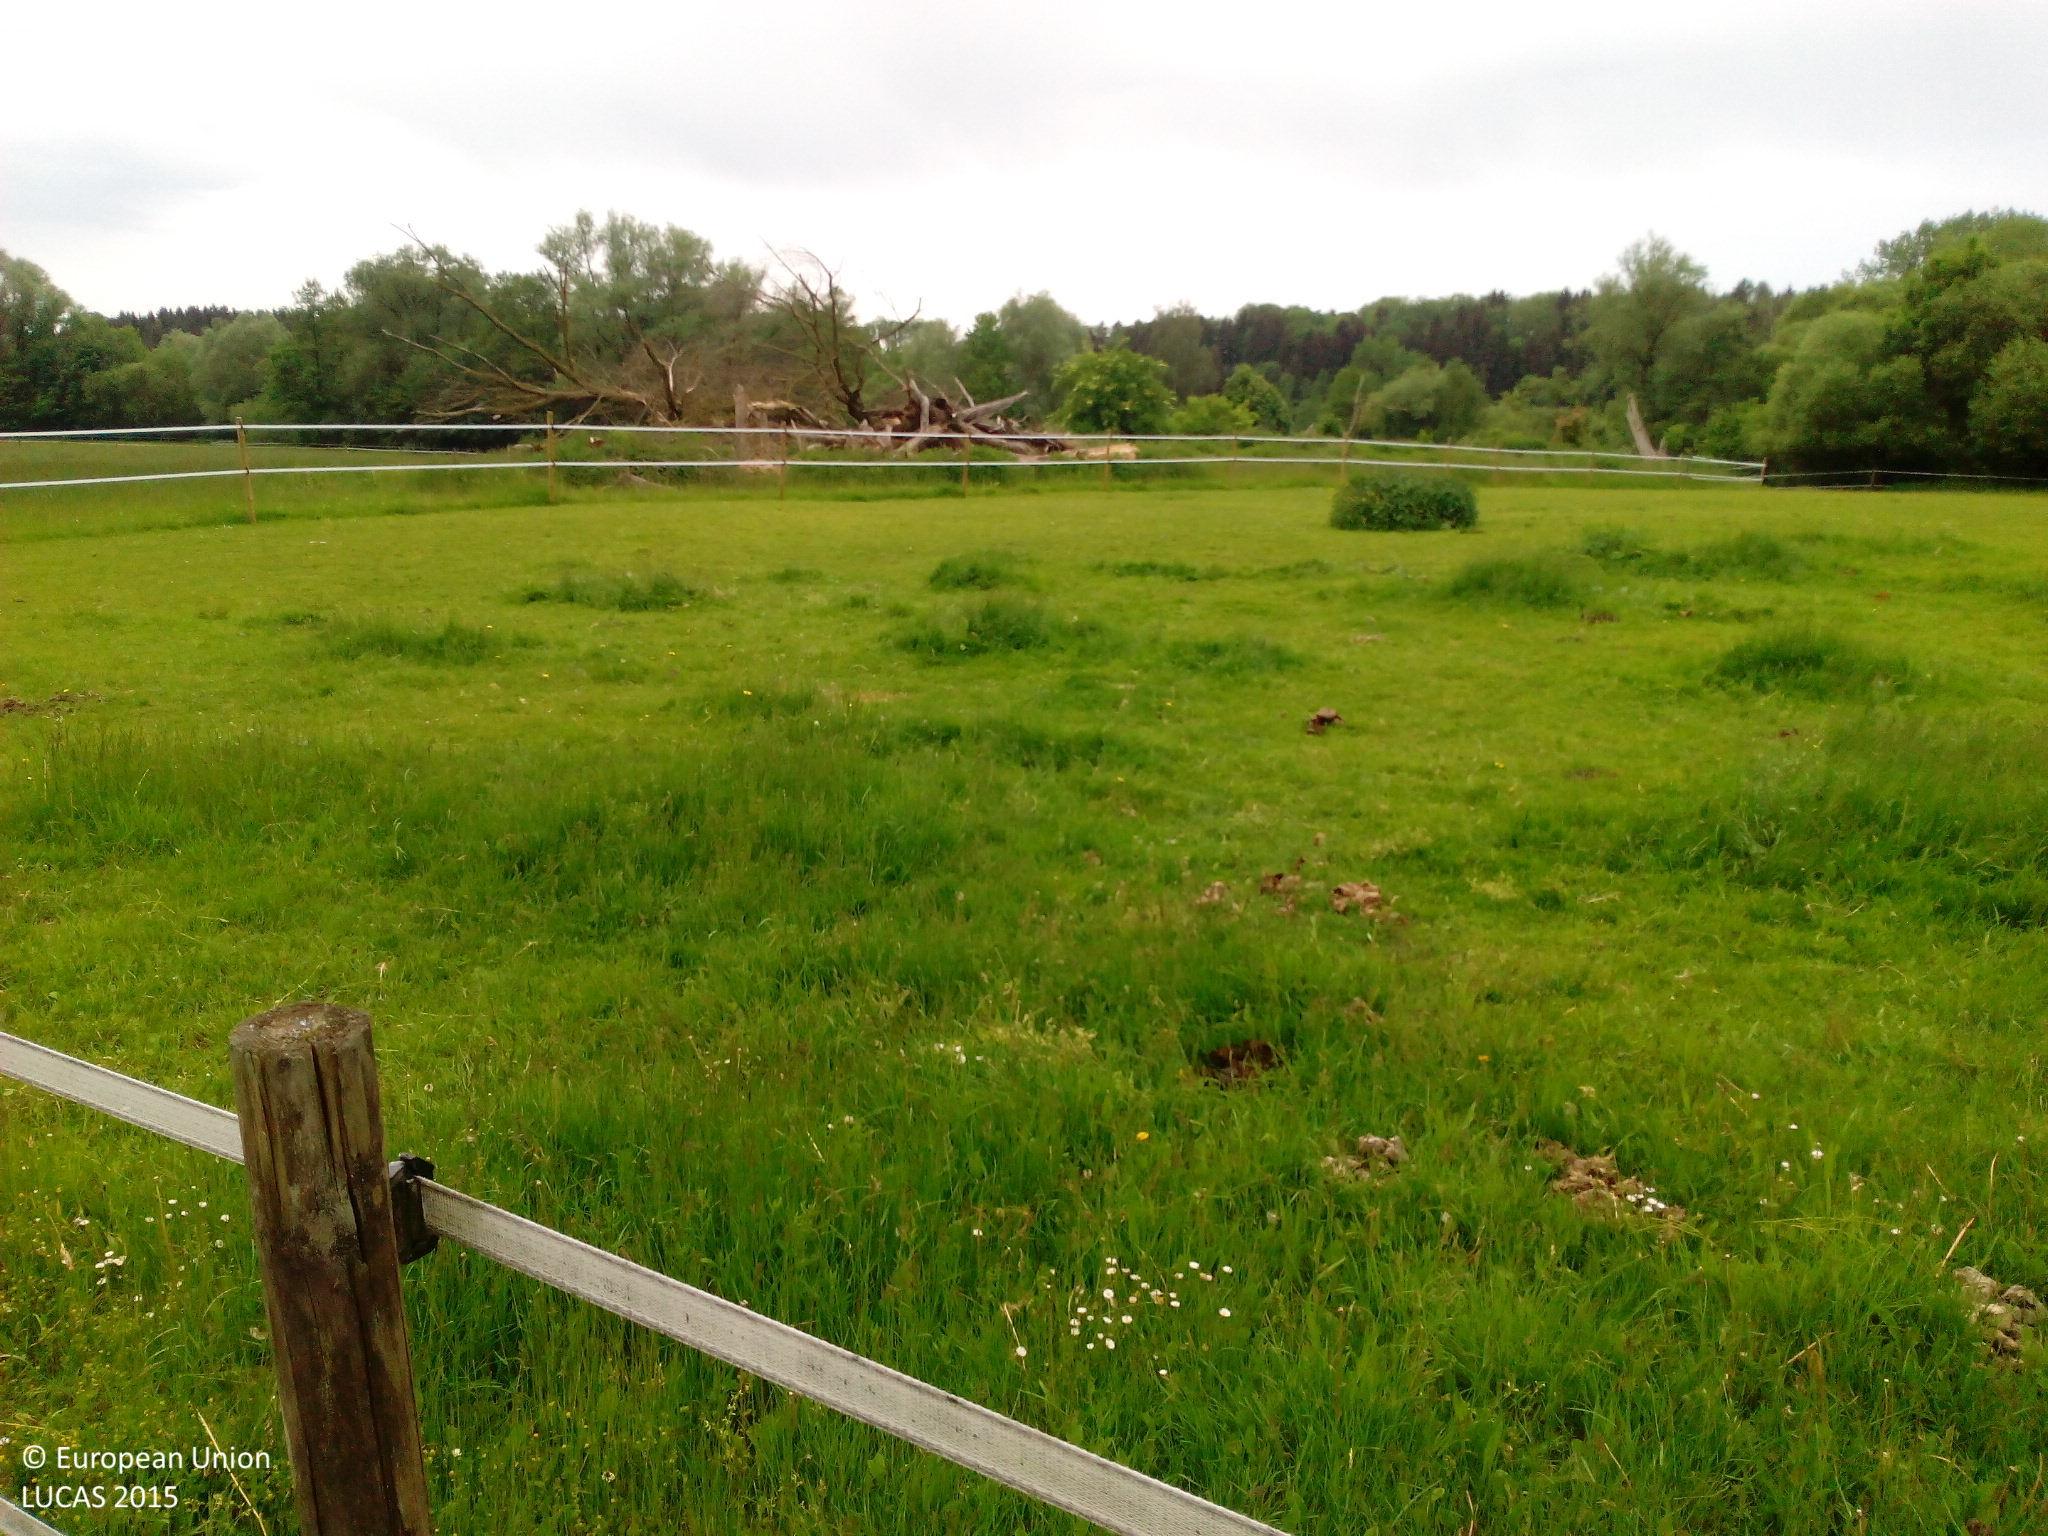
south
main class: Grassland
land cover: Grassland without tree/shrub cover
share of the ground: > 75 %
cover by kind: herbaceous plants 100 %
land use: Agriculture (excluding fallow land and kitchen gardens)
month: May
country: DE
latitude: 48.1333
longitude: 10.2551
